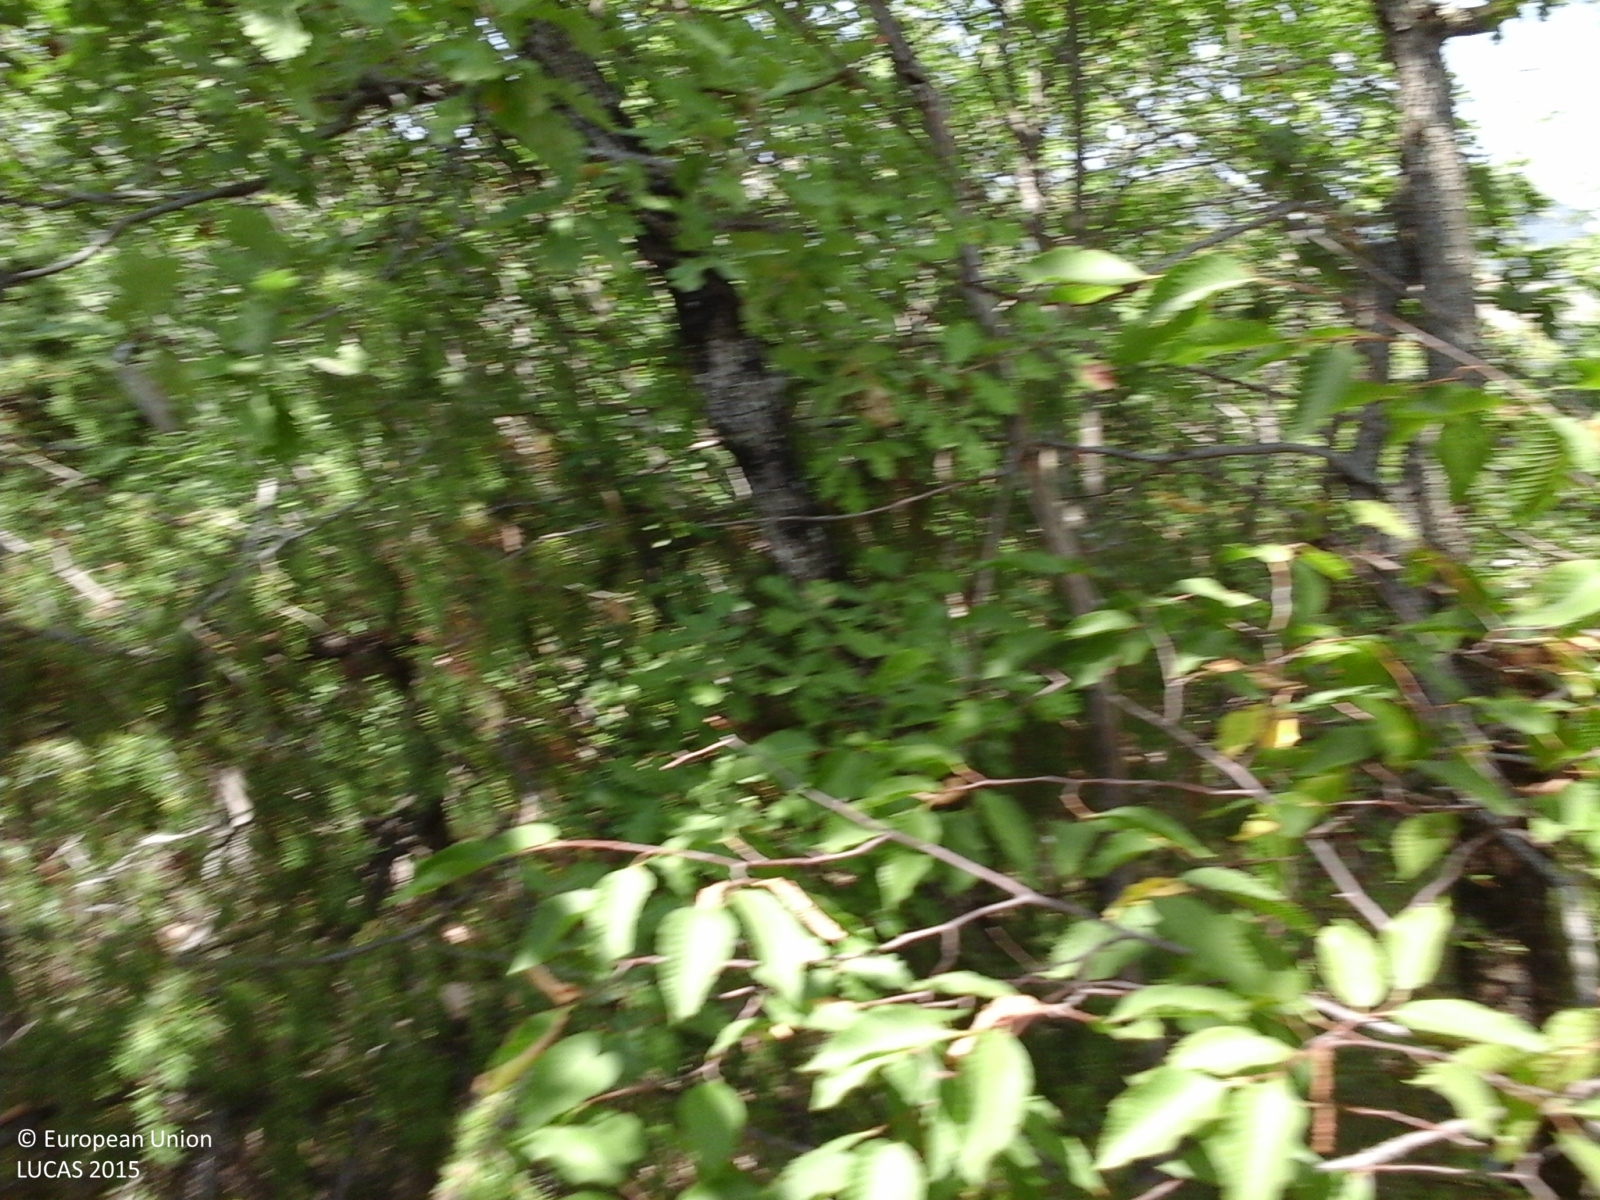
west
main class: Woodland
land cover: Broadleaved woodland
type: thermophilous deciduous forest
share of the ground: > 75 %
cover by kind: broadleaved forest trees 100 %
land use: Forestry
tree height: > 5 m
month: August
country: IT
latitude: 43.7053
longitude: 12.5624
